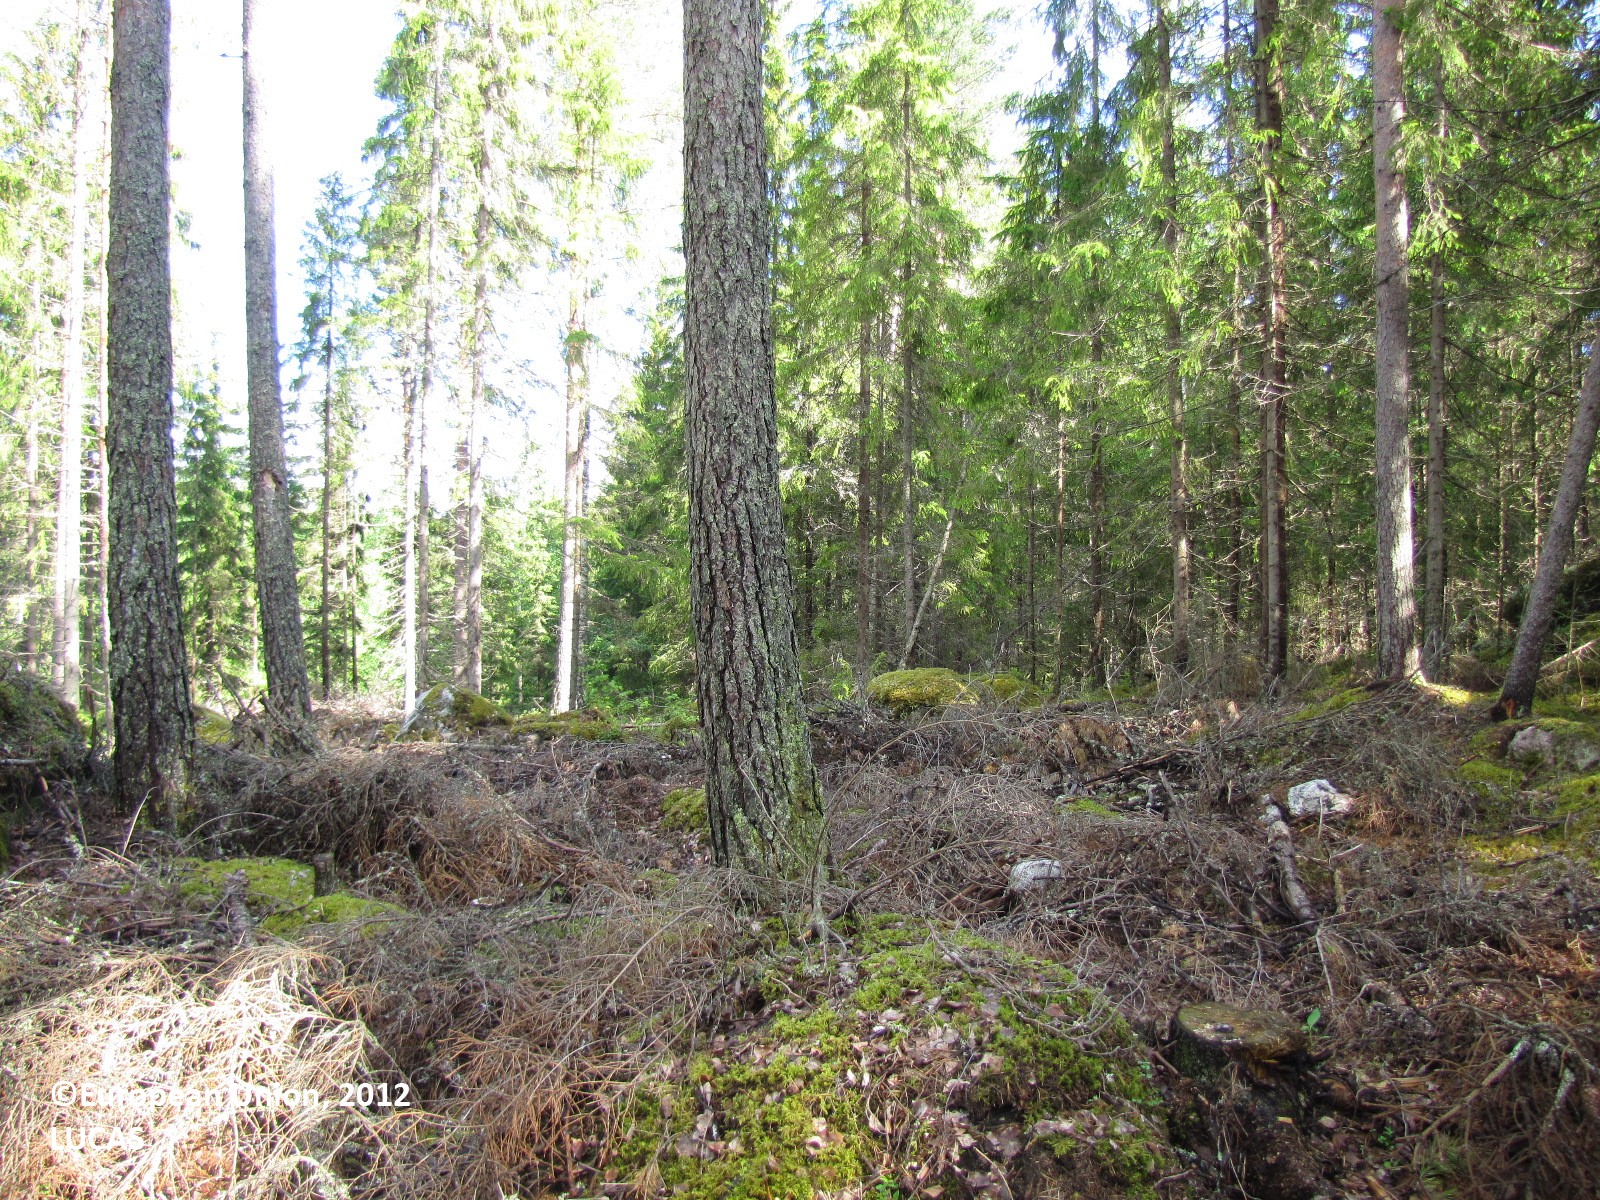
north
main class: Woodland
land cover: Pine dominated mixed woodland
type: boreal forest
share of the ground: 50 - 75 %
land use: Forestry
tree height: > 5 m
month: June
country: FI
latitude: 61.3936
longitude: 24.6502
